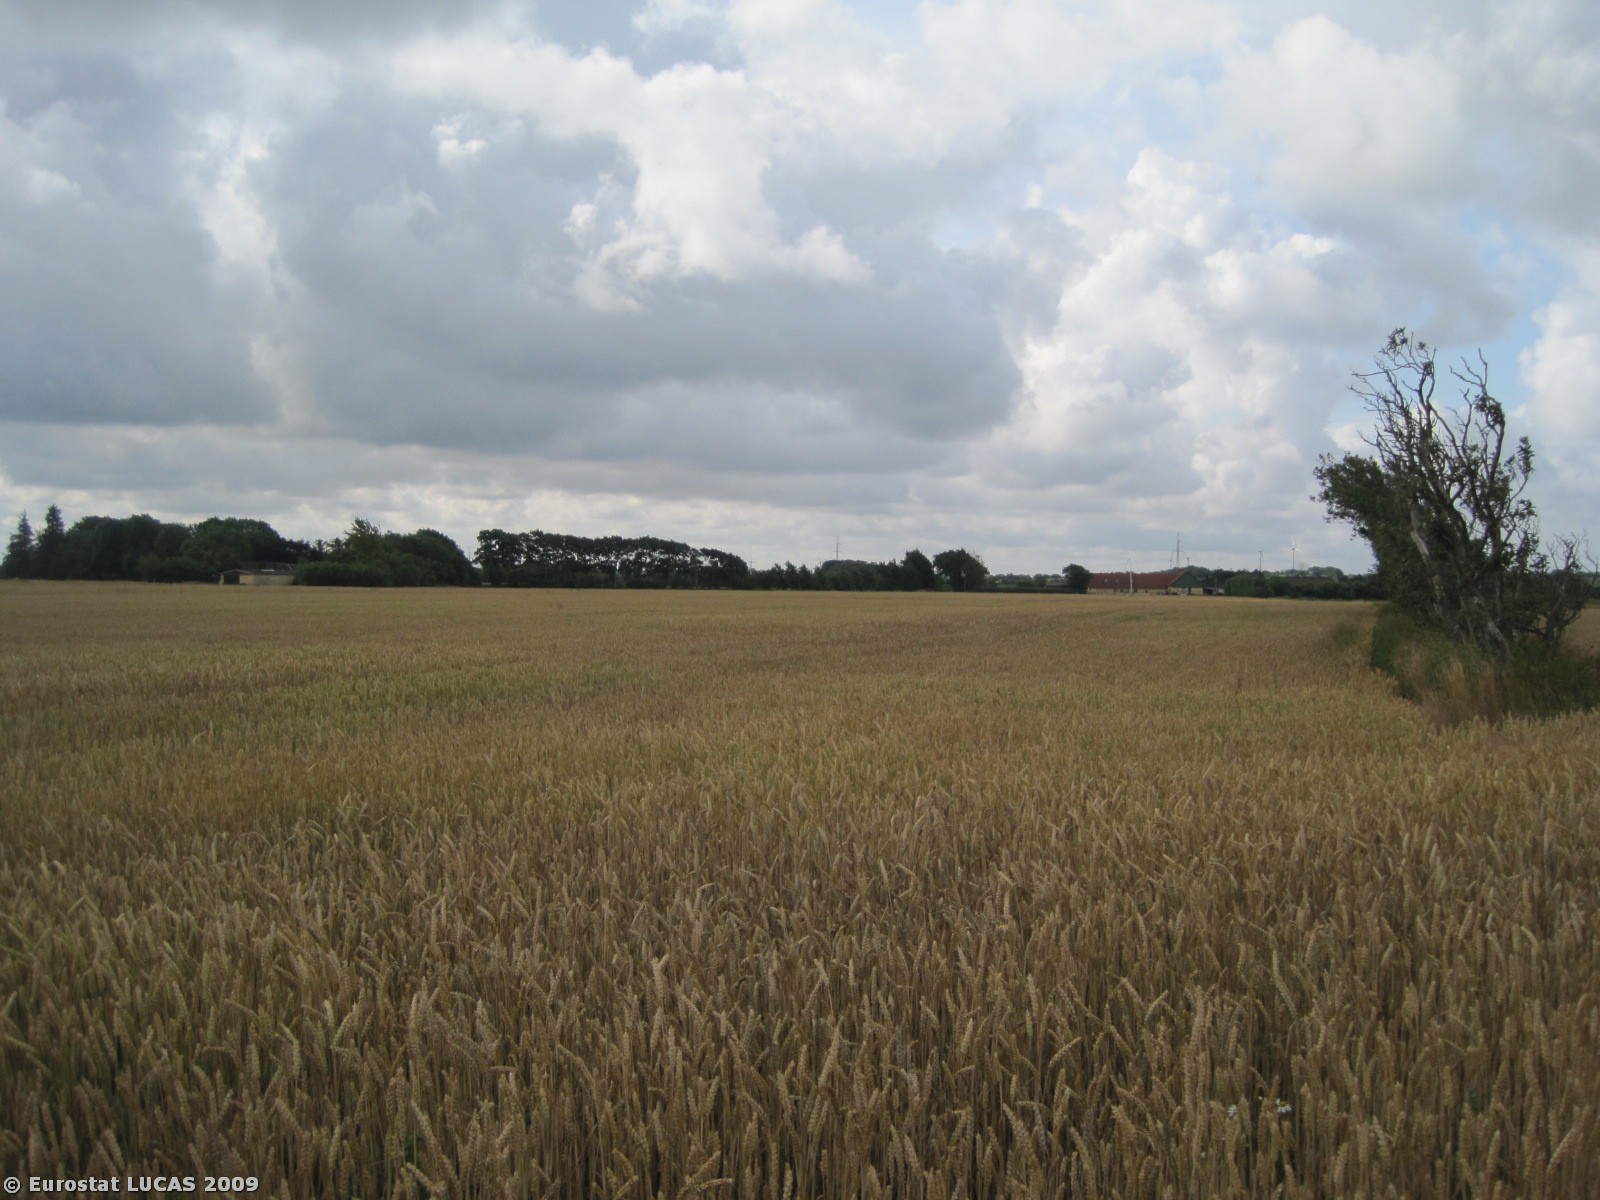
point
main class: Cropland
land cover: Common wheat
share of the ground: > 75 %
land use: Agriculture (excluding fallow land and kitchen gardens)
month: July
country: DK
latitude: 57.0483
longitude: 9.2264
